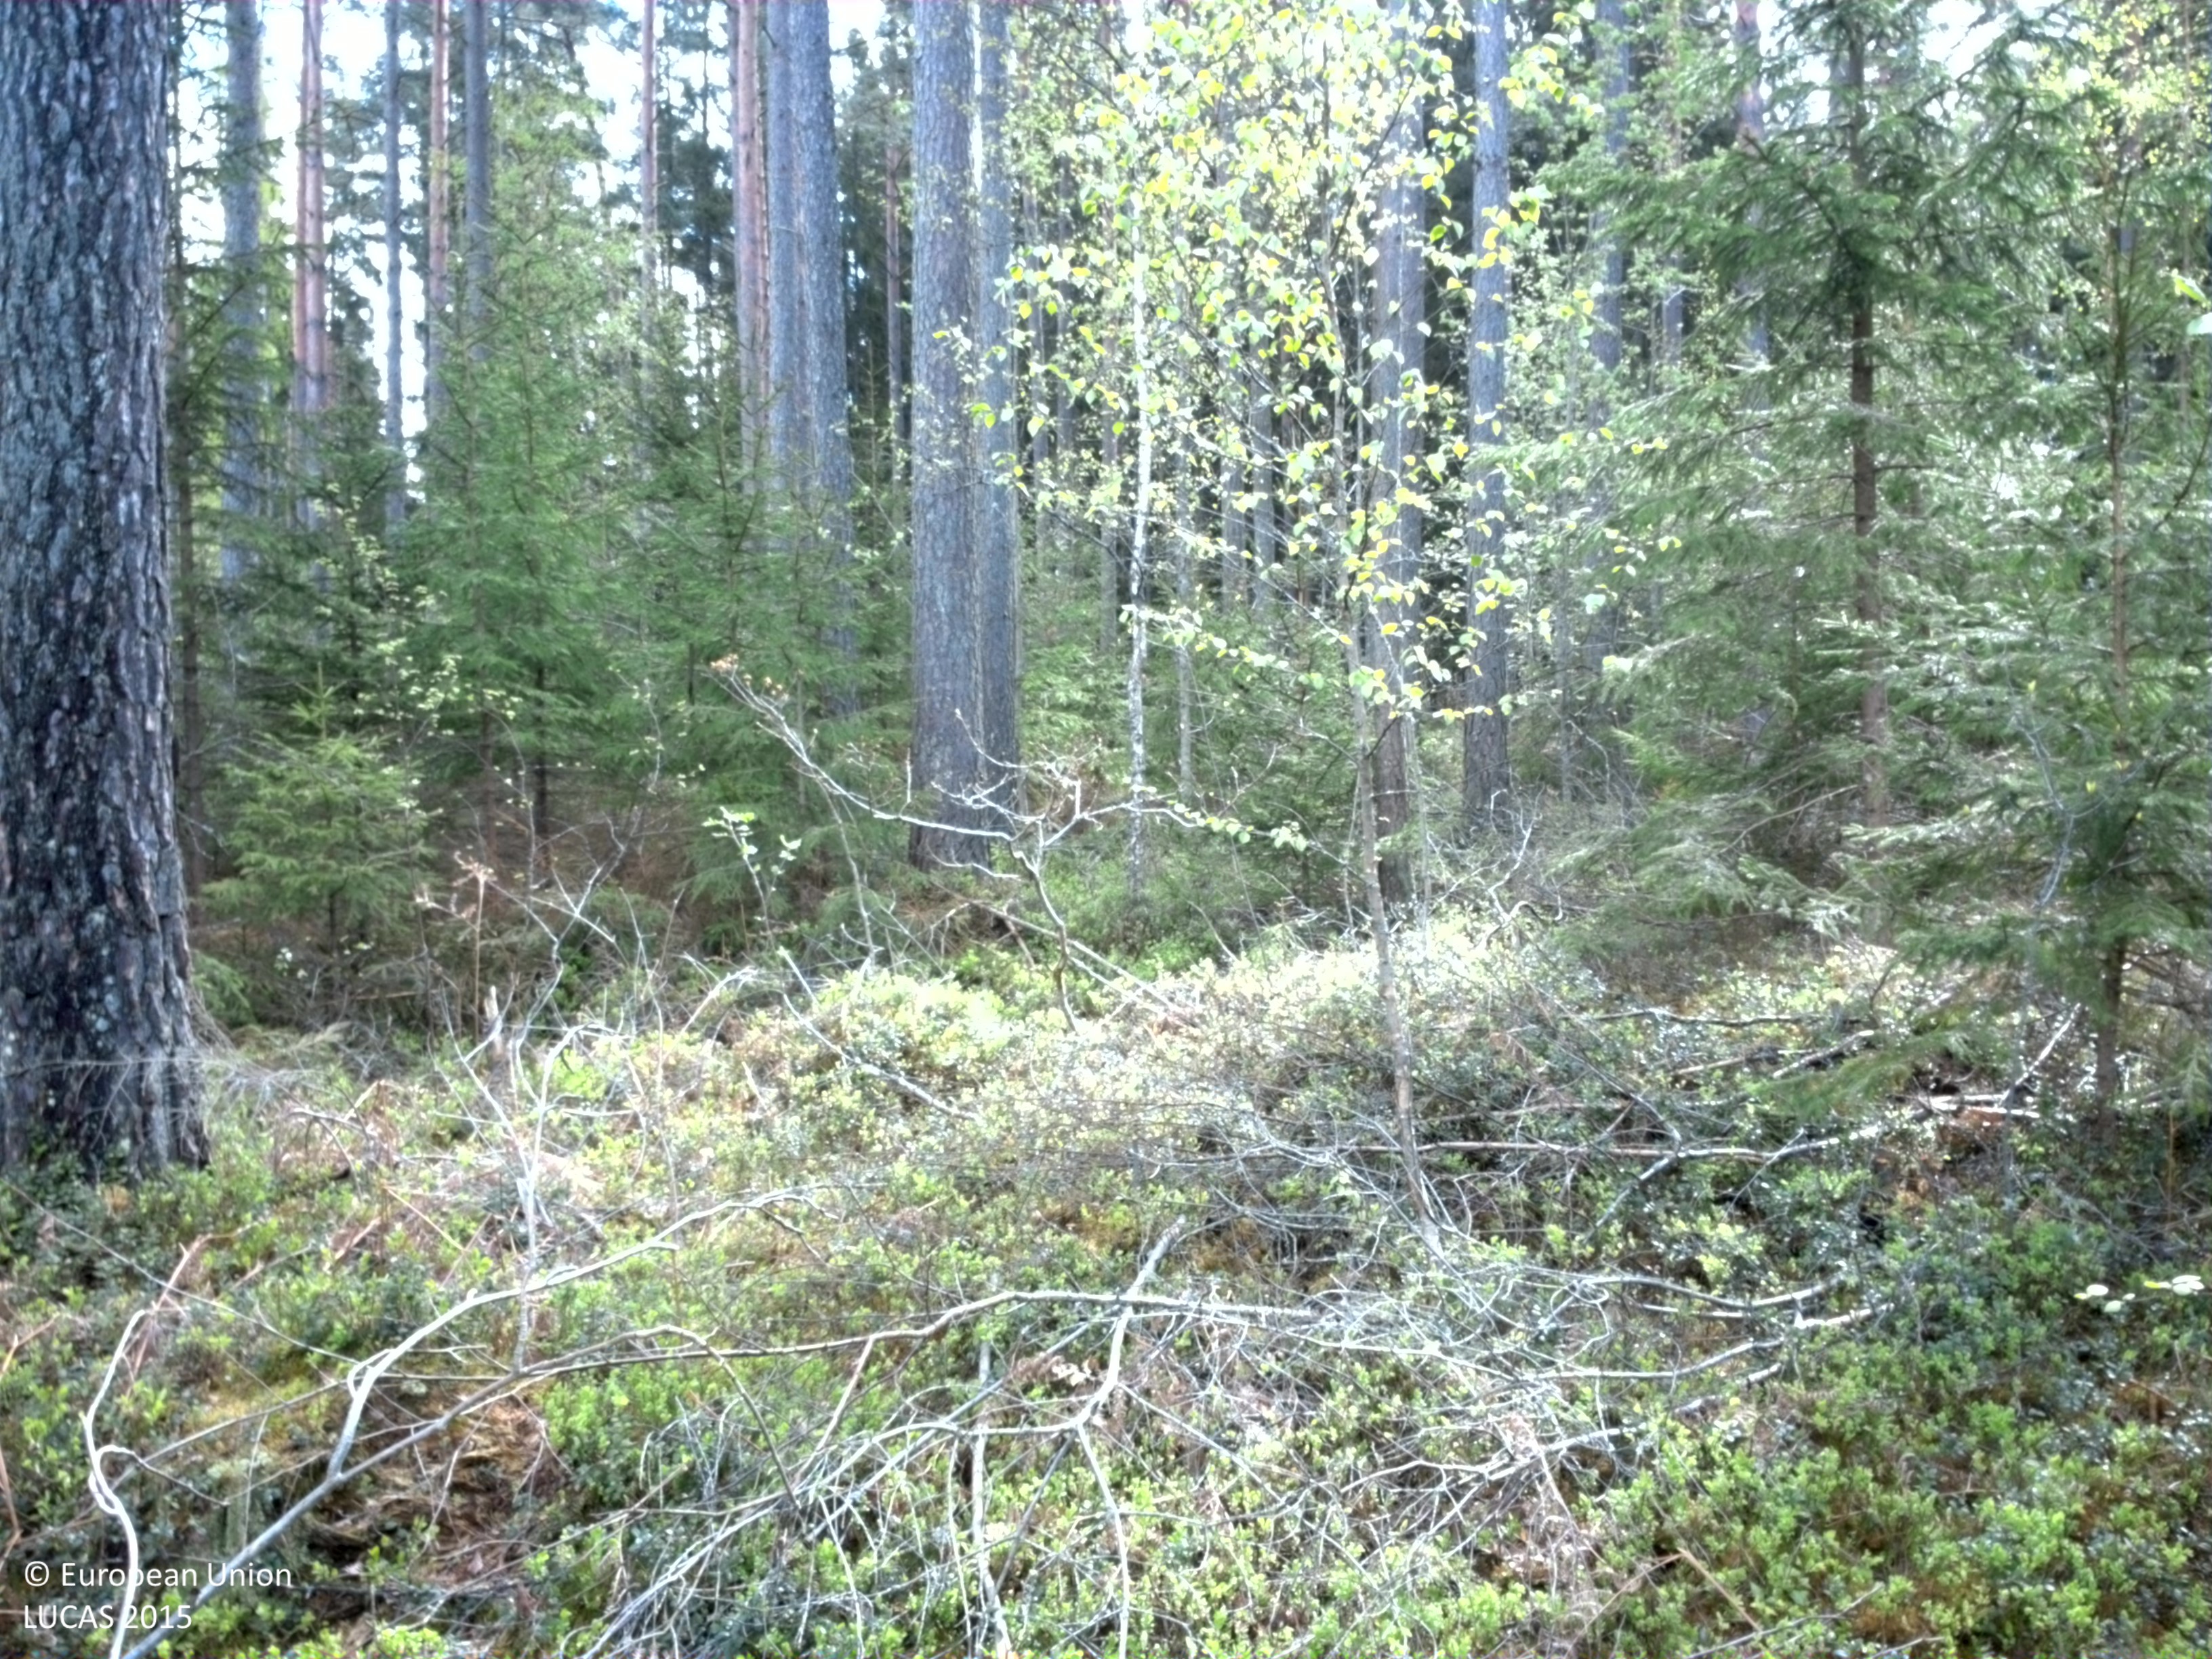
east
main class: Woodland
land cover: Pine dominated coniferous woodland
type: boreal forest
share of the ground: > 75 %
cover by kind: coniferous forest trees 60 %, broadleaved forest trees 20 %, lichens and mosses 10 %, shrubs 5 %, herbaceous plants 5 %
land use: Forestry
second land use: Amenities, museums, leisure
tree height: > 5 m
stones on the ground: < 10 %
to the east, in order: Pine dominated coniferous woodland; Tracks; Spruce dominated coniferous woodland; Tracks; Spruce dominated coniferous woodland; Broadleaved woodland
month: May
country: SE
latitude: 56.9095
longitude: 14.7761
